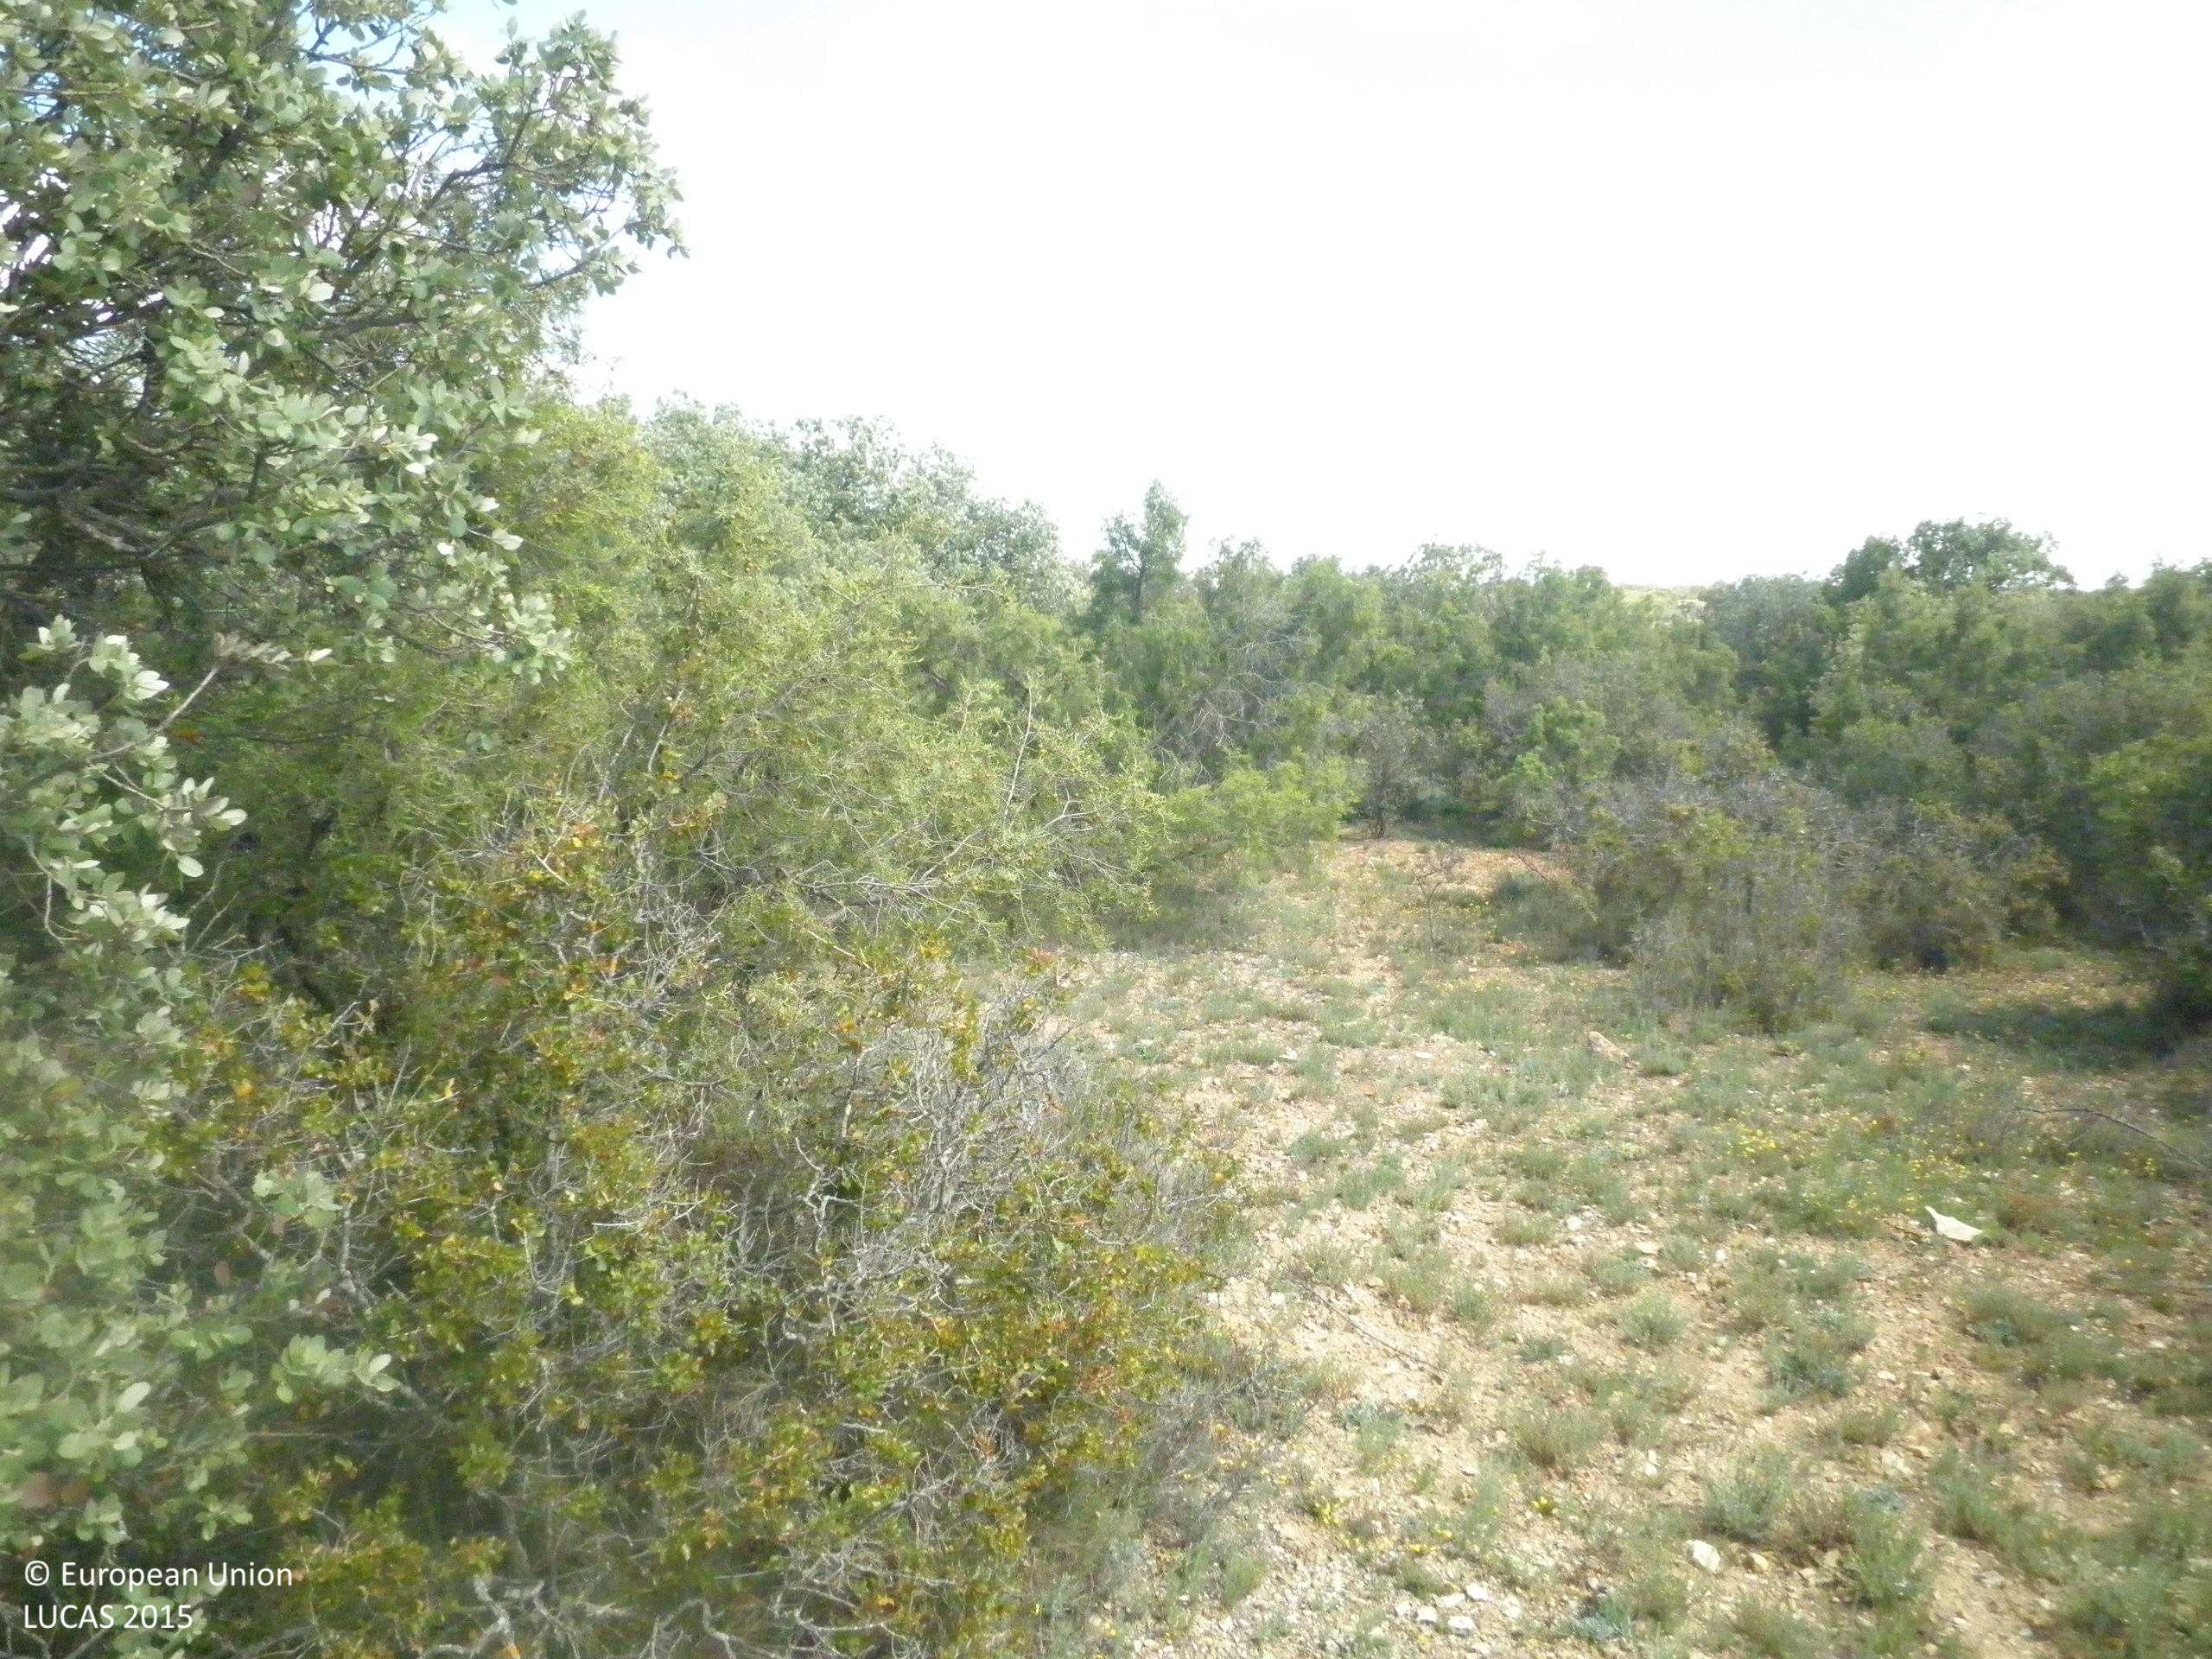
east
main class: Woodland
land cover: Broadleaved woodland
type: broadleaved evergreen forest
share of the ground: 25 - 50 %
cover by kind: shrubs 30 %, broadleaved forest trees 25 %, herbaceous plants 15 %, consolidated bare surface 15 %, unconsolidated bare surface 15 %
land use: Semi-natural and natural areas not in use
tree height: < 5 m
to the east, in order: Broadleaved woodland
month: May
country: ES
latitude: 39.6594
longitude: -2.8269
